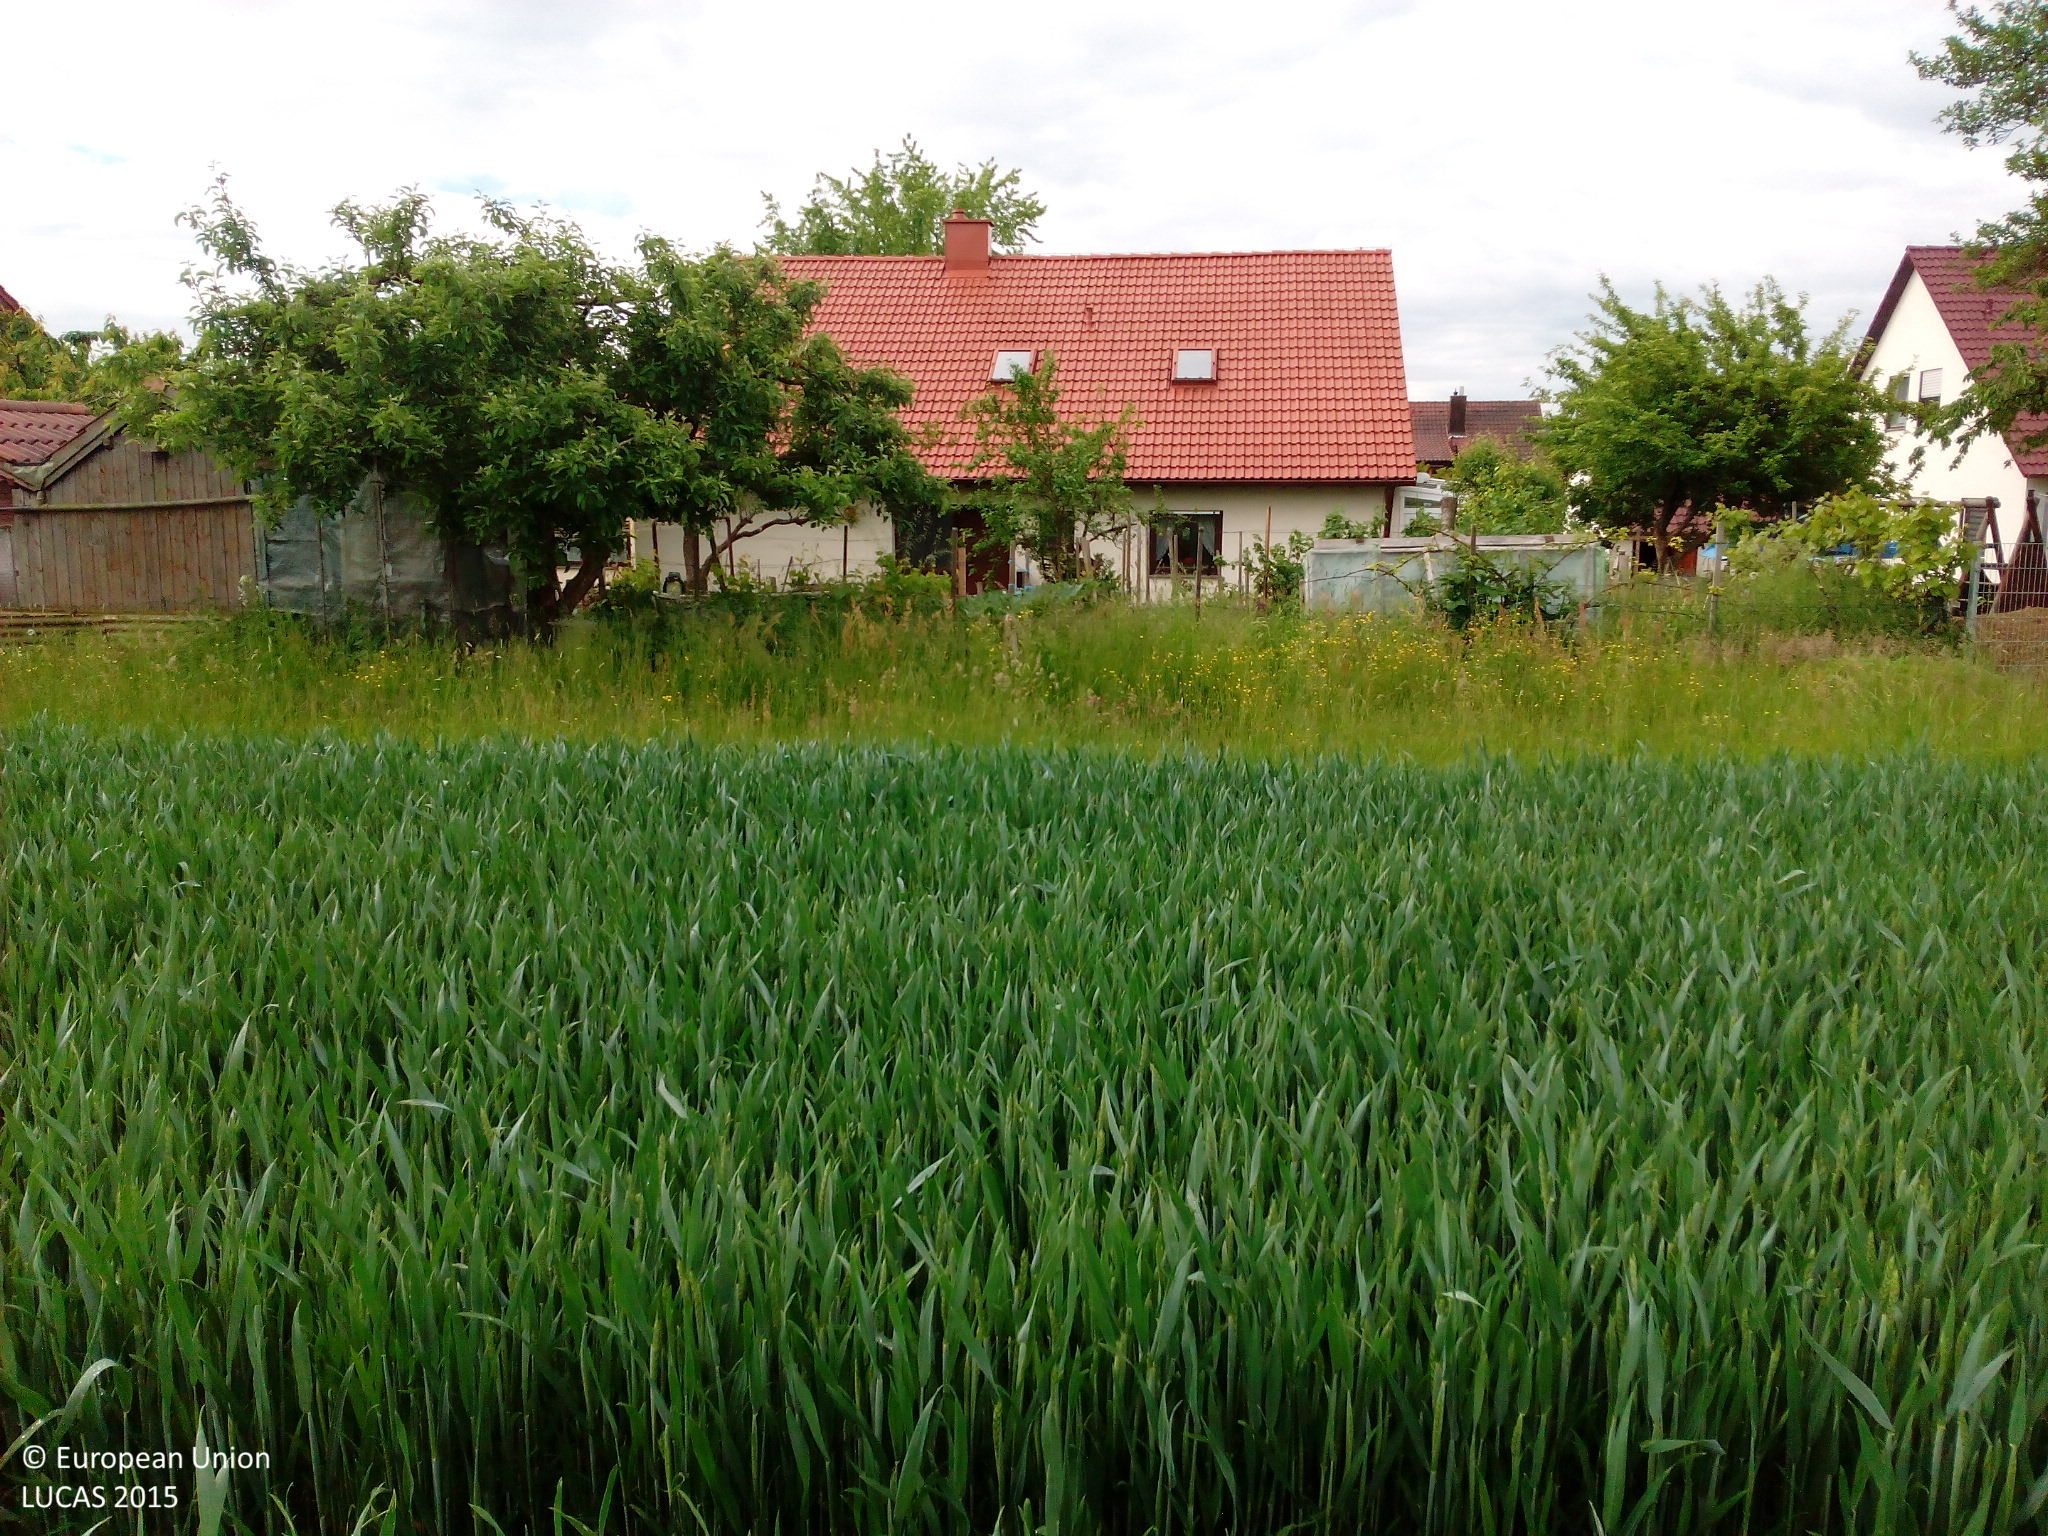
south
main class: Cropland
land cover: Common wheat
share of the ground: > 75 %
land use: Agriculture (excluding fallow land and kitchen gardens)
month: June
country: DE
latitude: 49.0867
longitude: 9.6852
